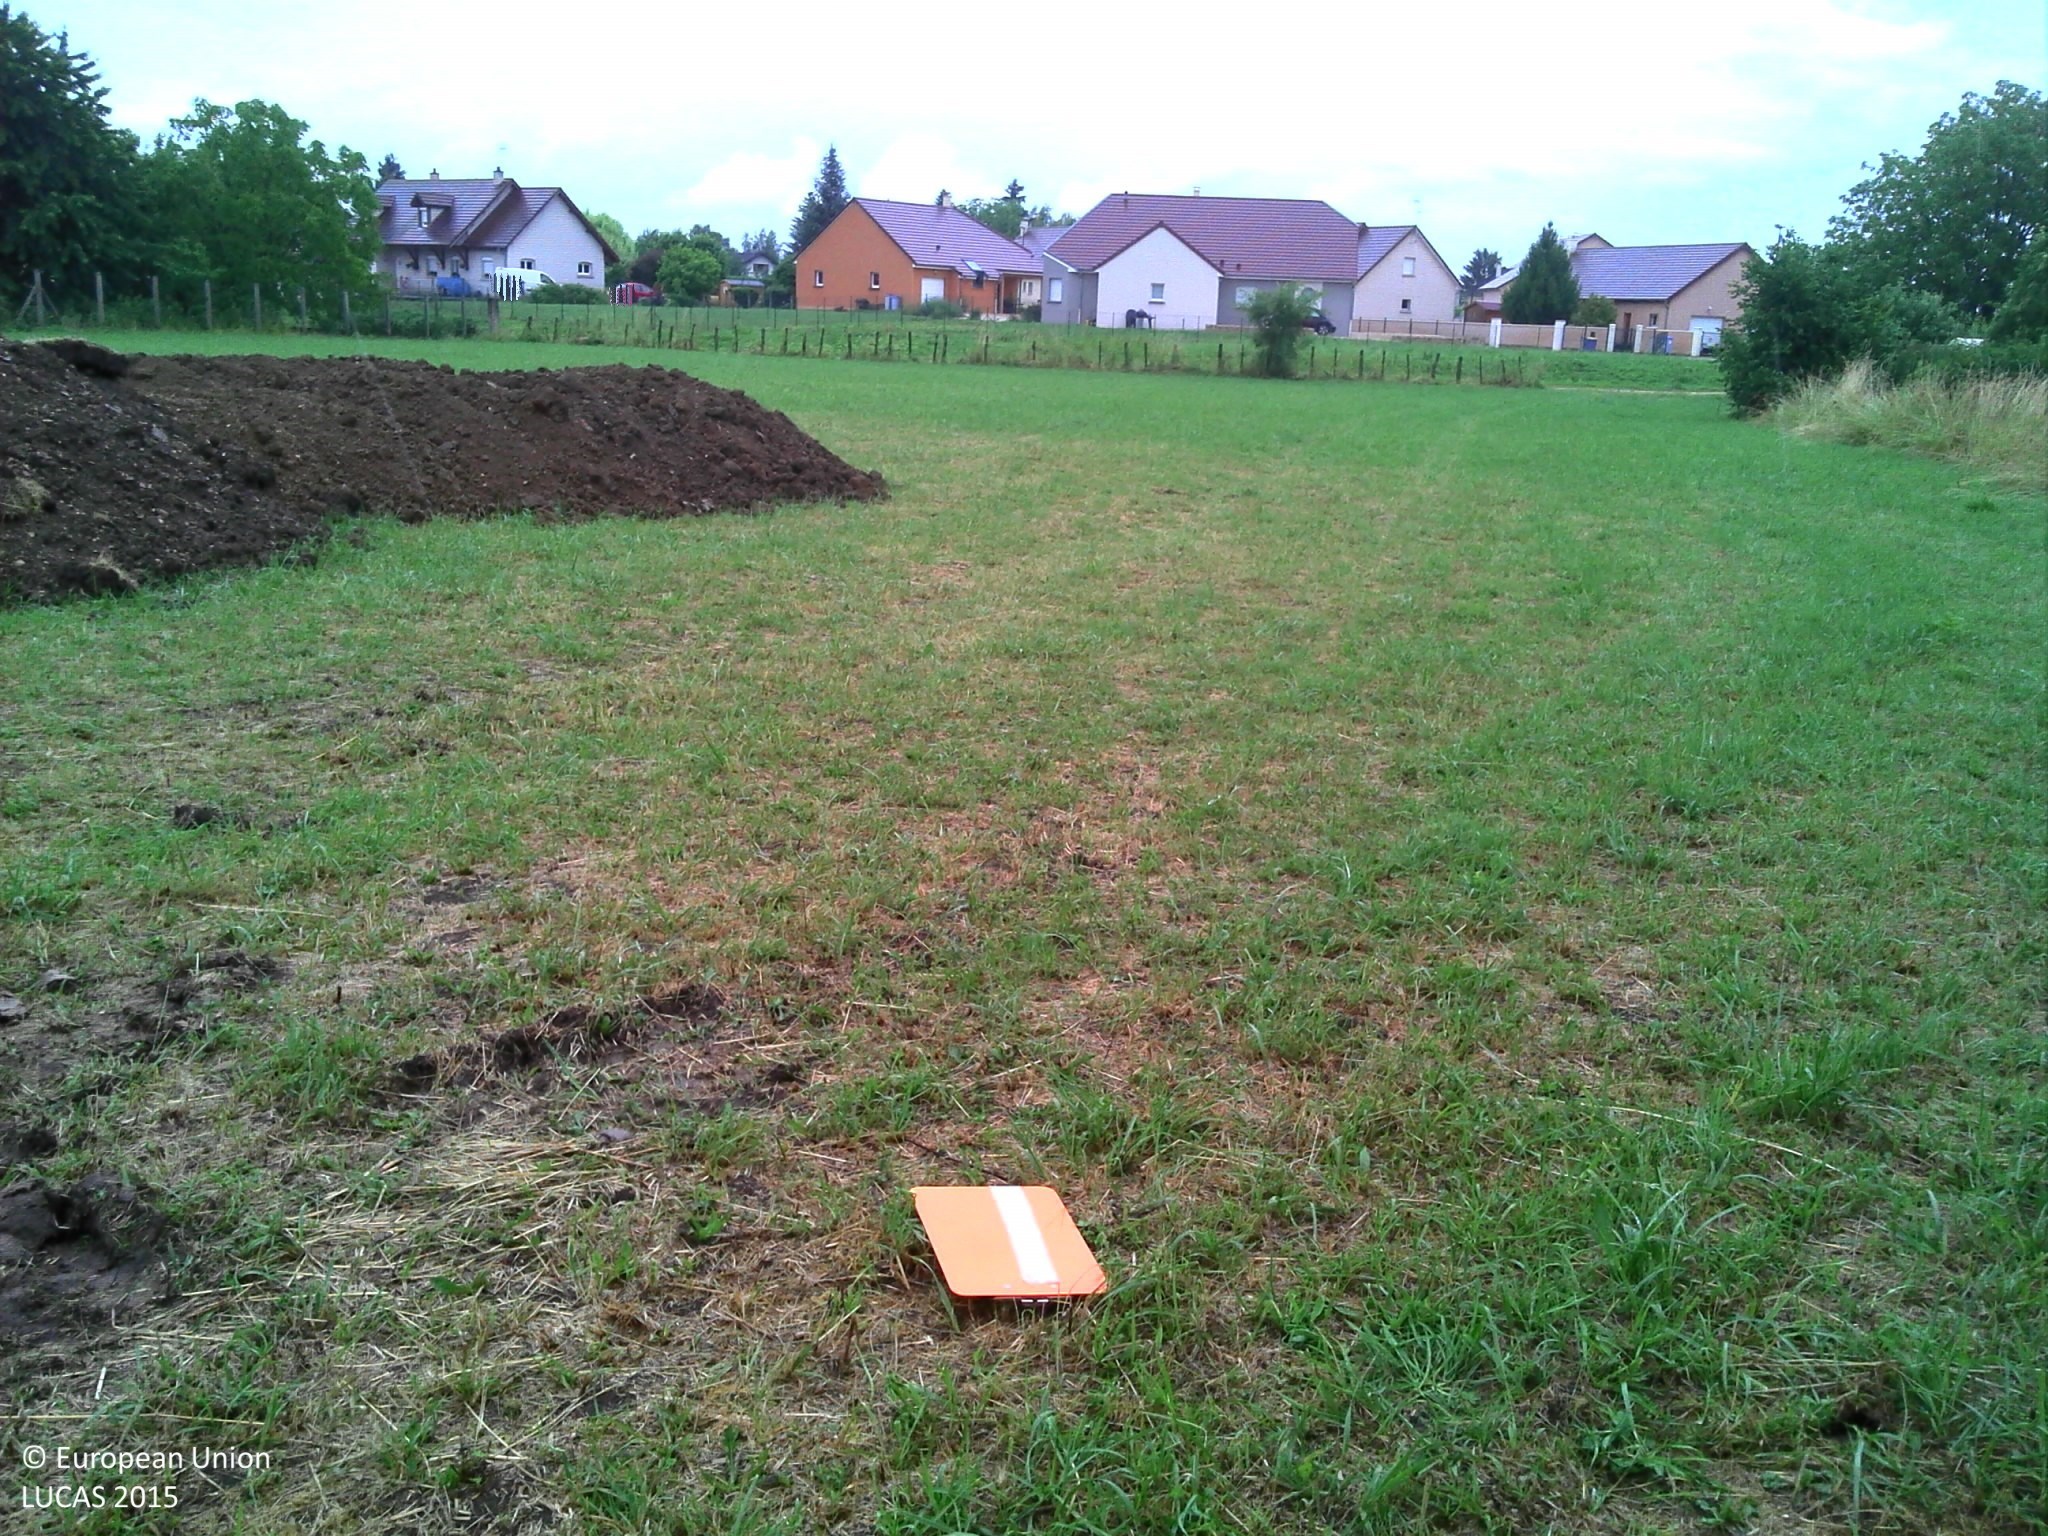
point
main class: Grassland
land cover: Grassland without tree/shrub cover
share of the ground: > 75 %
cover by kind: herbaceous plants 100 %
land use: Residential
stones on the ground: < 10 %
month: June
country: FR
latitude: 47.0092
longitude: 5.3847
